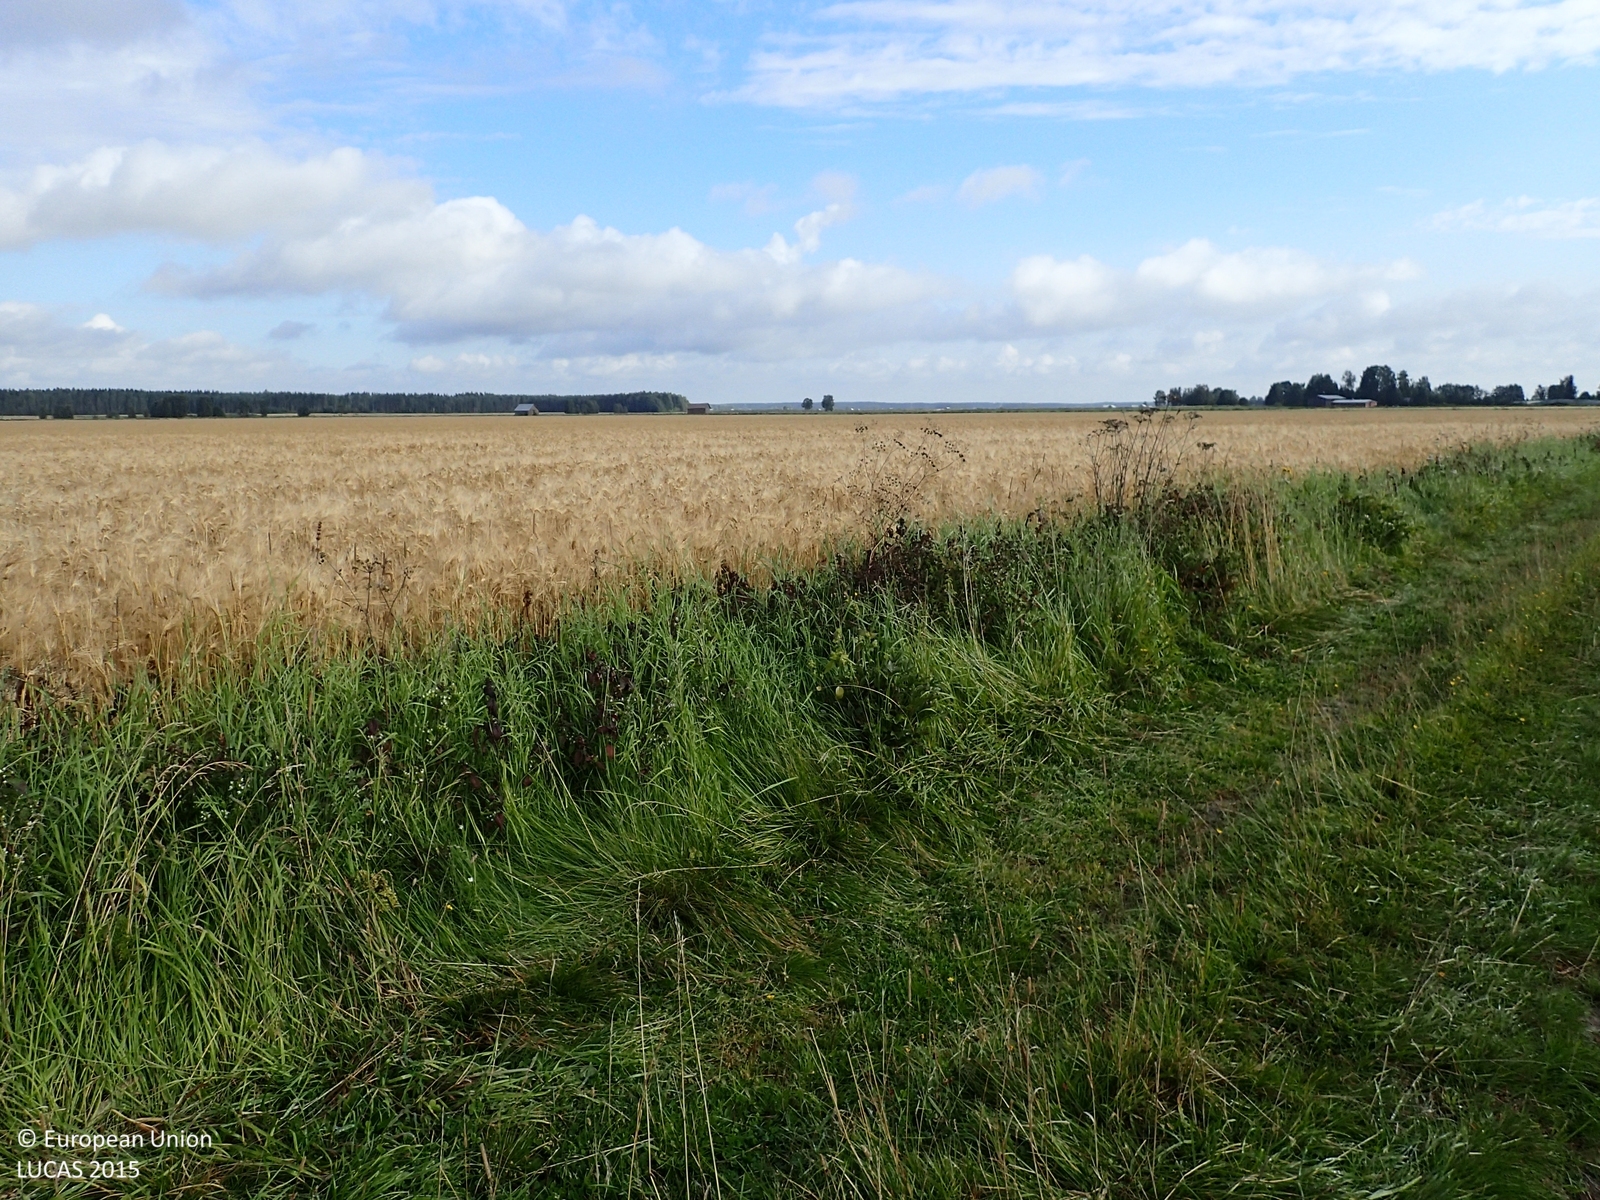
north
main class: Cropland
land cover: Barley
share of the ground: > 75 %
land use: Agriculture (excluding fallow land and kitchen gardens)
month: August
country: FI
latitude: 62.7750
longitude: 22.6142
